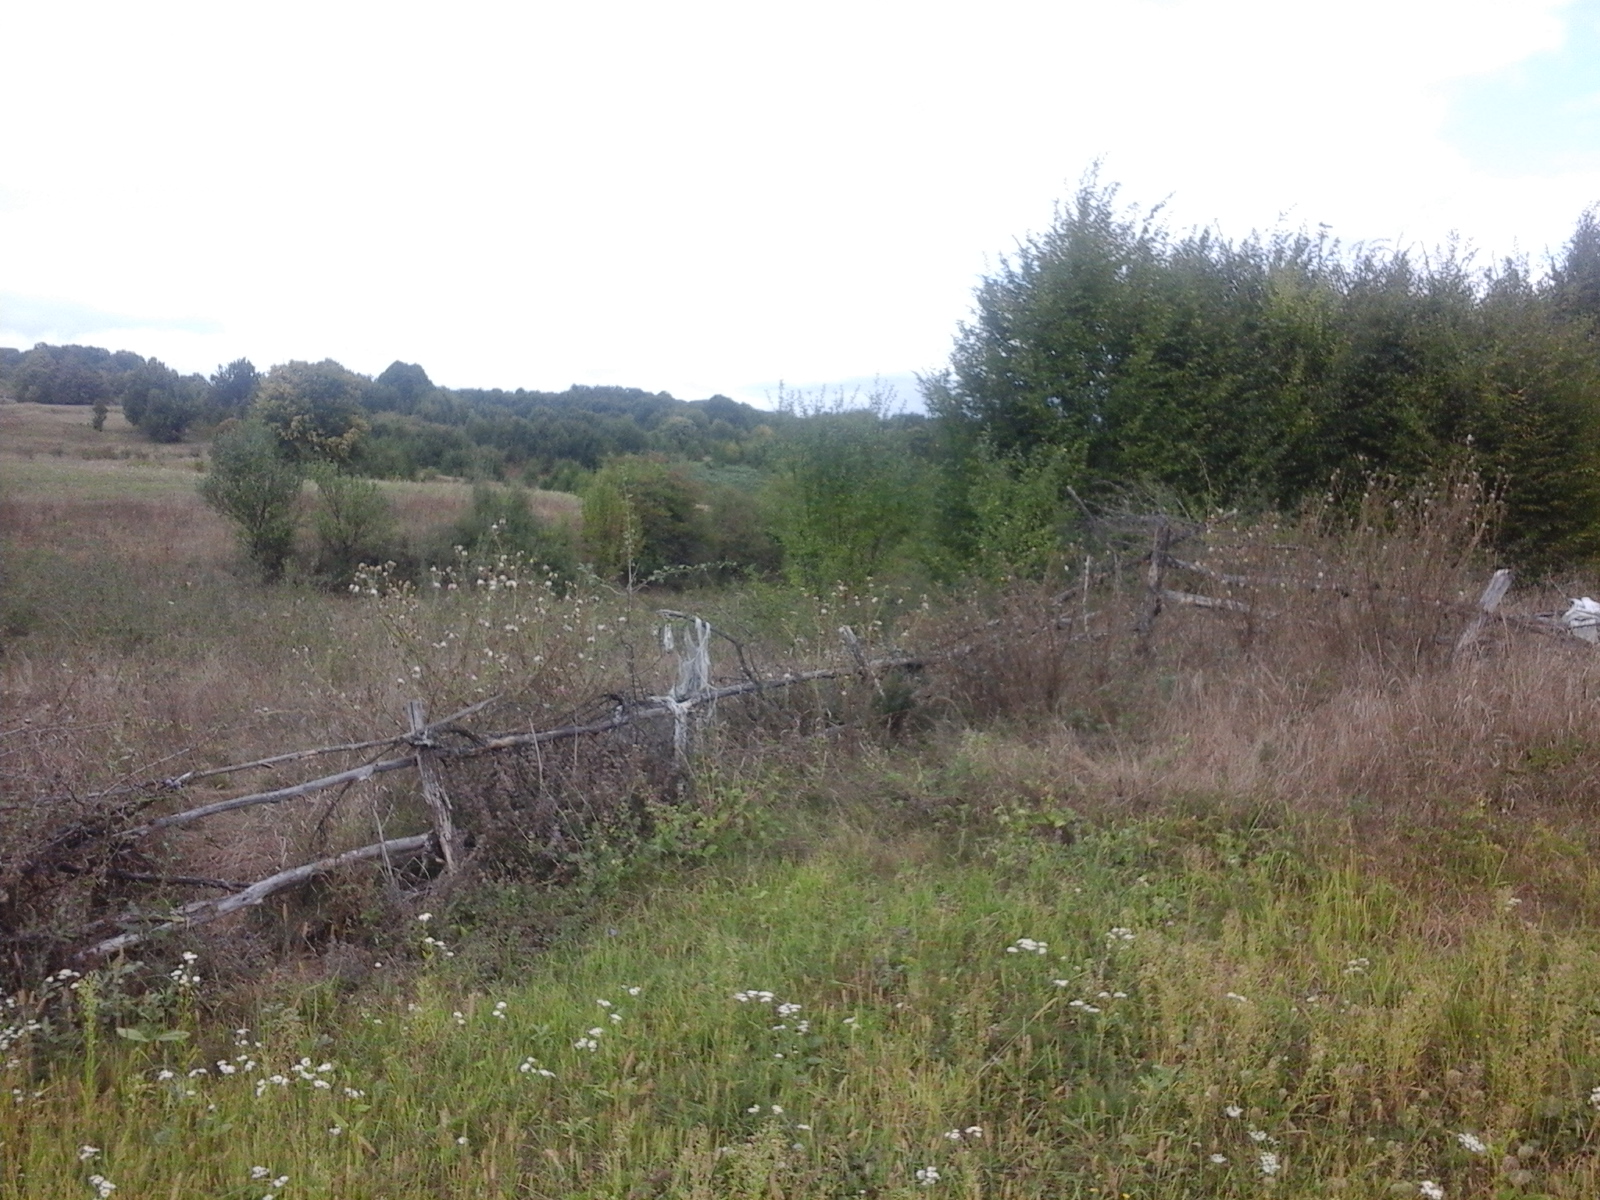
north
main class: Grassland
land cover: Grassland without tree/shrub cover
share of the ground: > 75 %
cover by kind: herbaceous plants 100 %
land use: Agriculture (excluding fallow land and kitchen gardens)
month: September
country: RO
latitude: 47.4303
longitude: 23.7466
